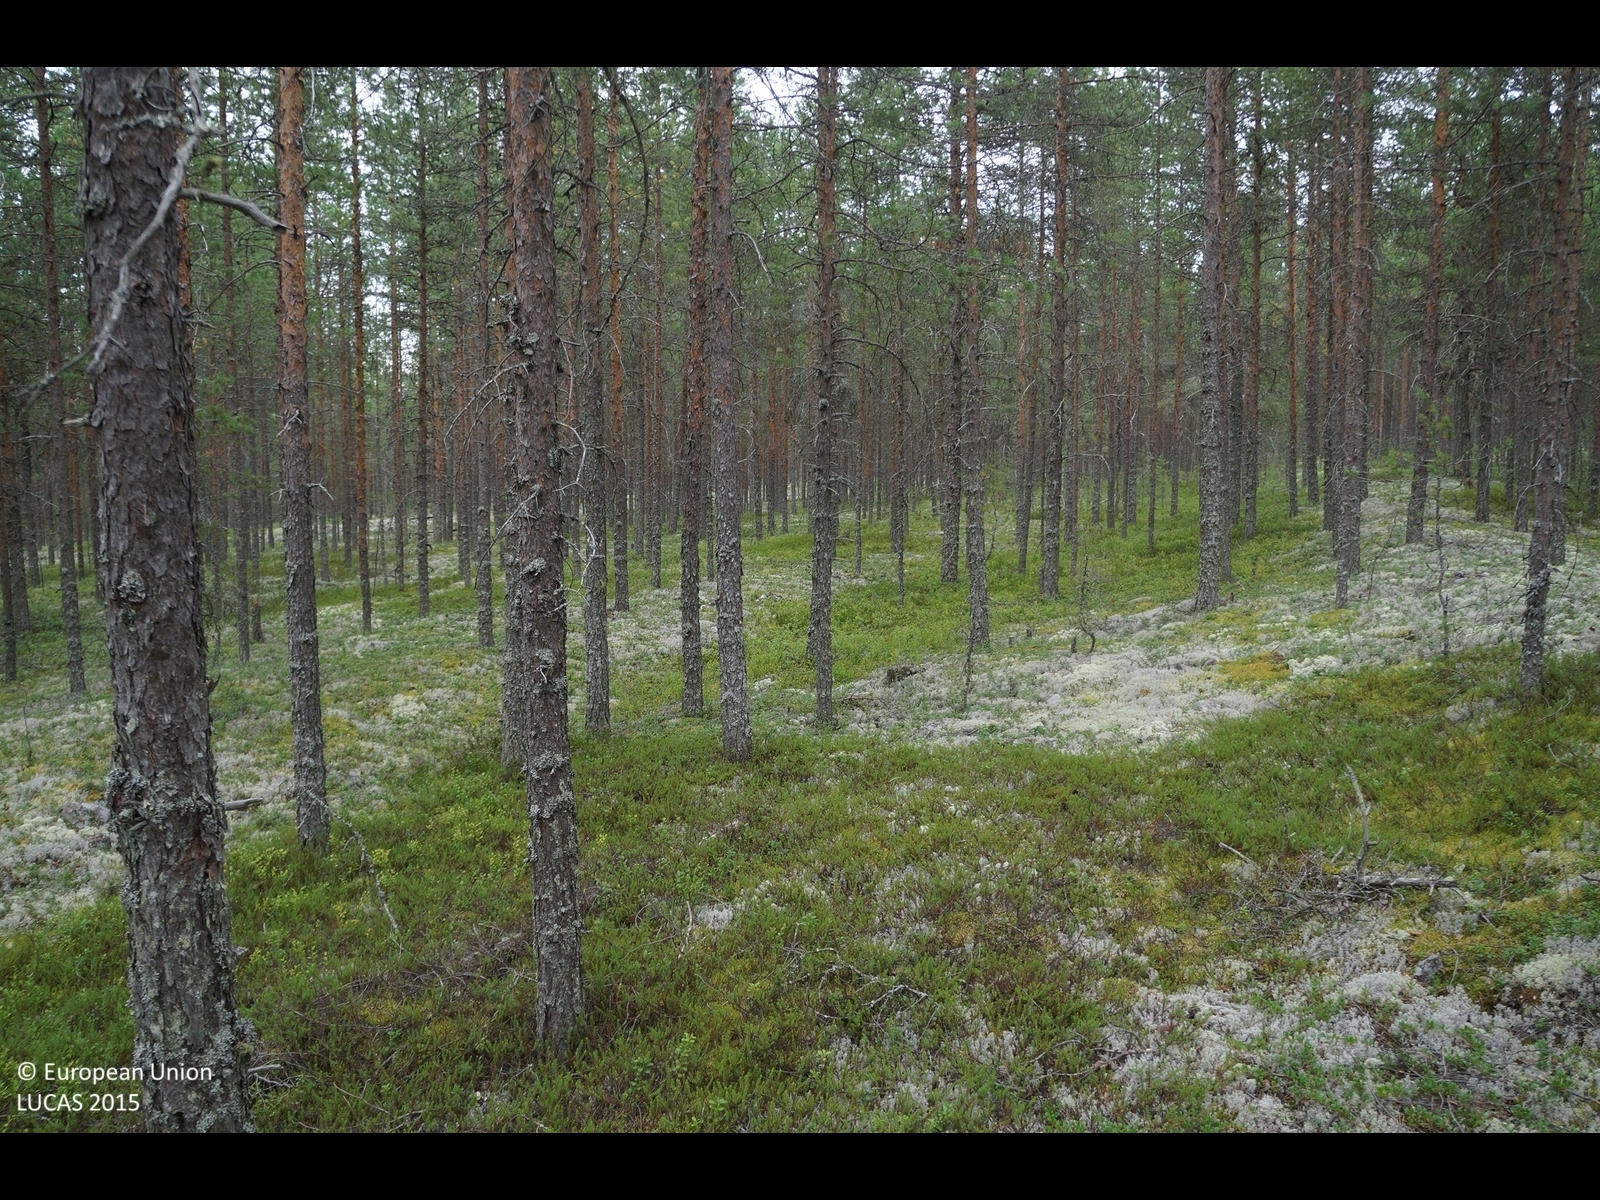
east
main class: Woodland
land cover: Pine dominated coniferous woodland
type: boreal forest
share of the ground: 50 - 75 %
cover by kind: coniferous forest trees 50 %, lichens and mosses 35 %, shrubs 15 %
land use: Forestry
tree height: > 5 m
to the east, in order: Pine dominated coniferous woodland
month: August
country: FI
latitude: 64.8131
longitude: 24.9209
